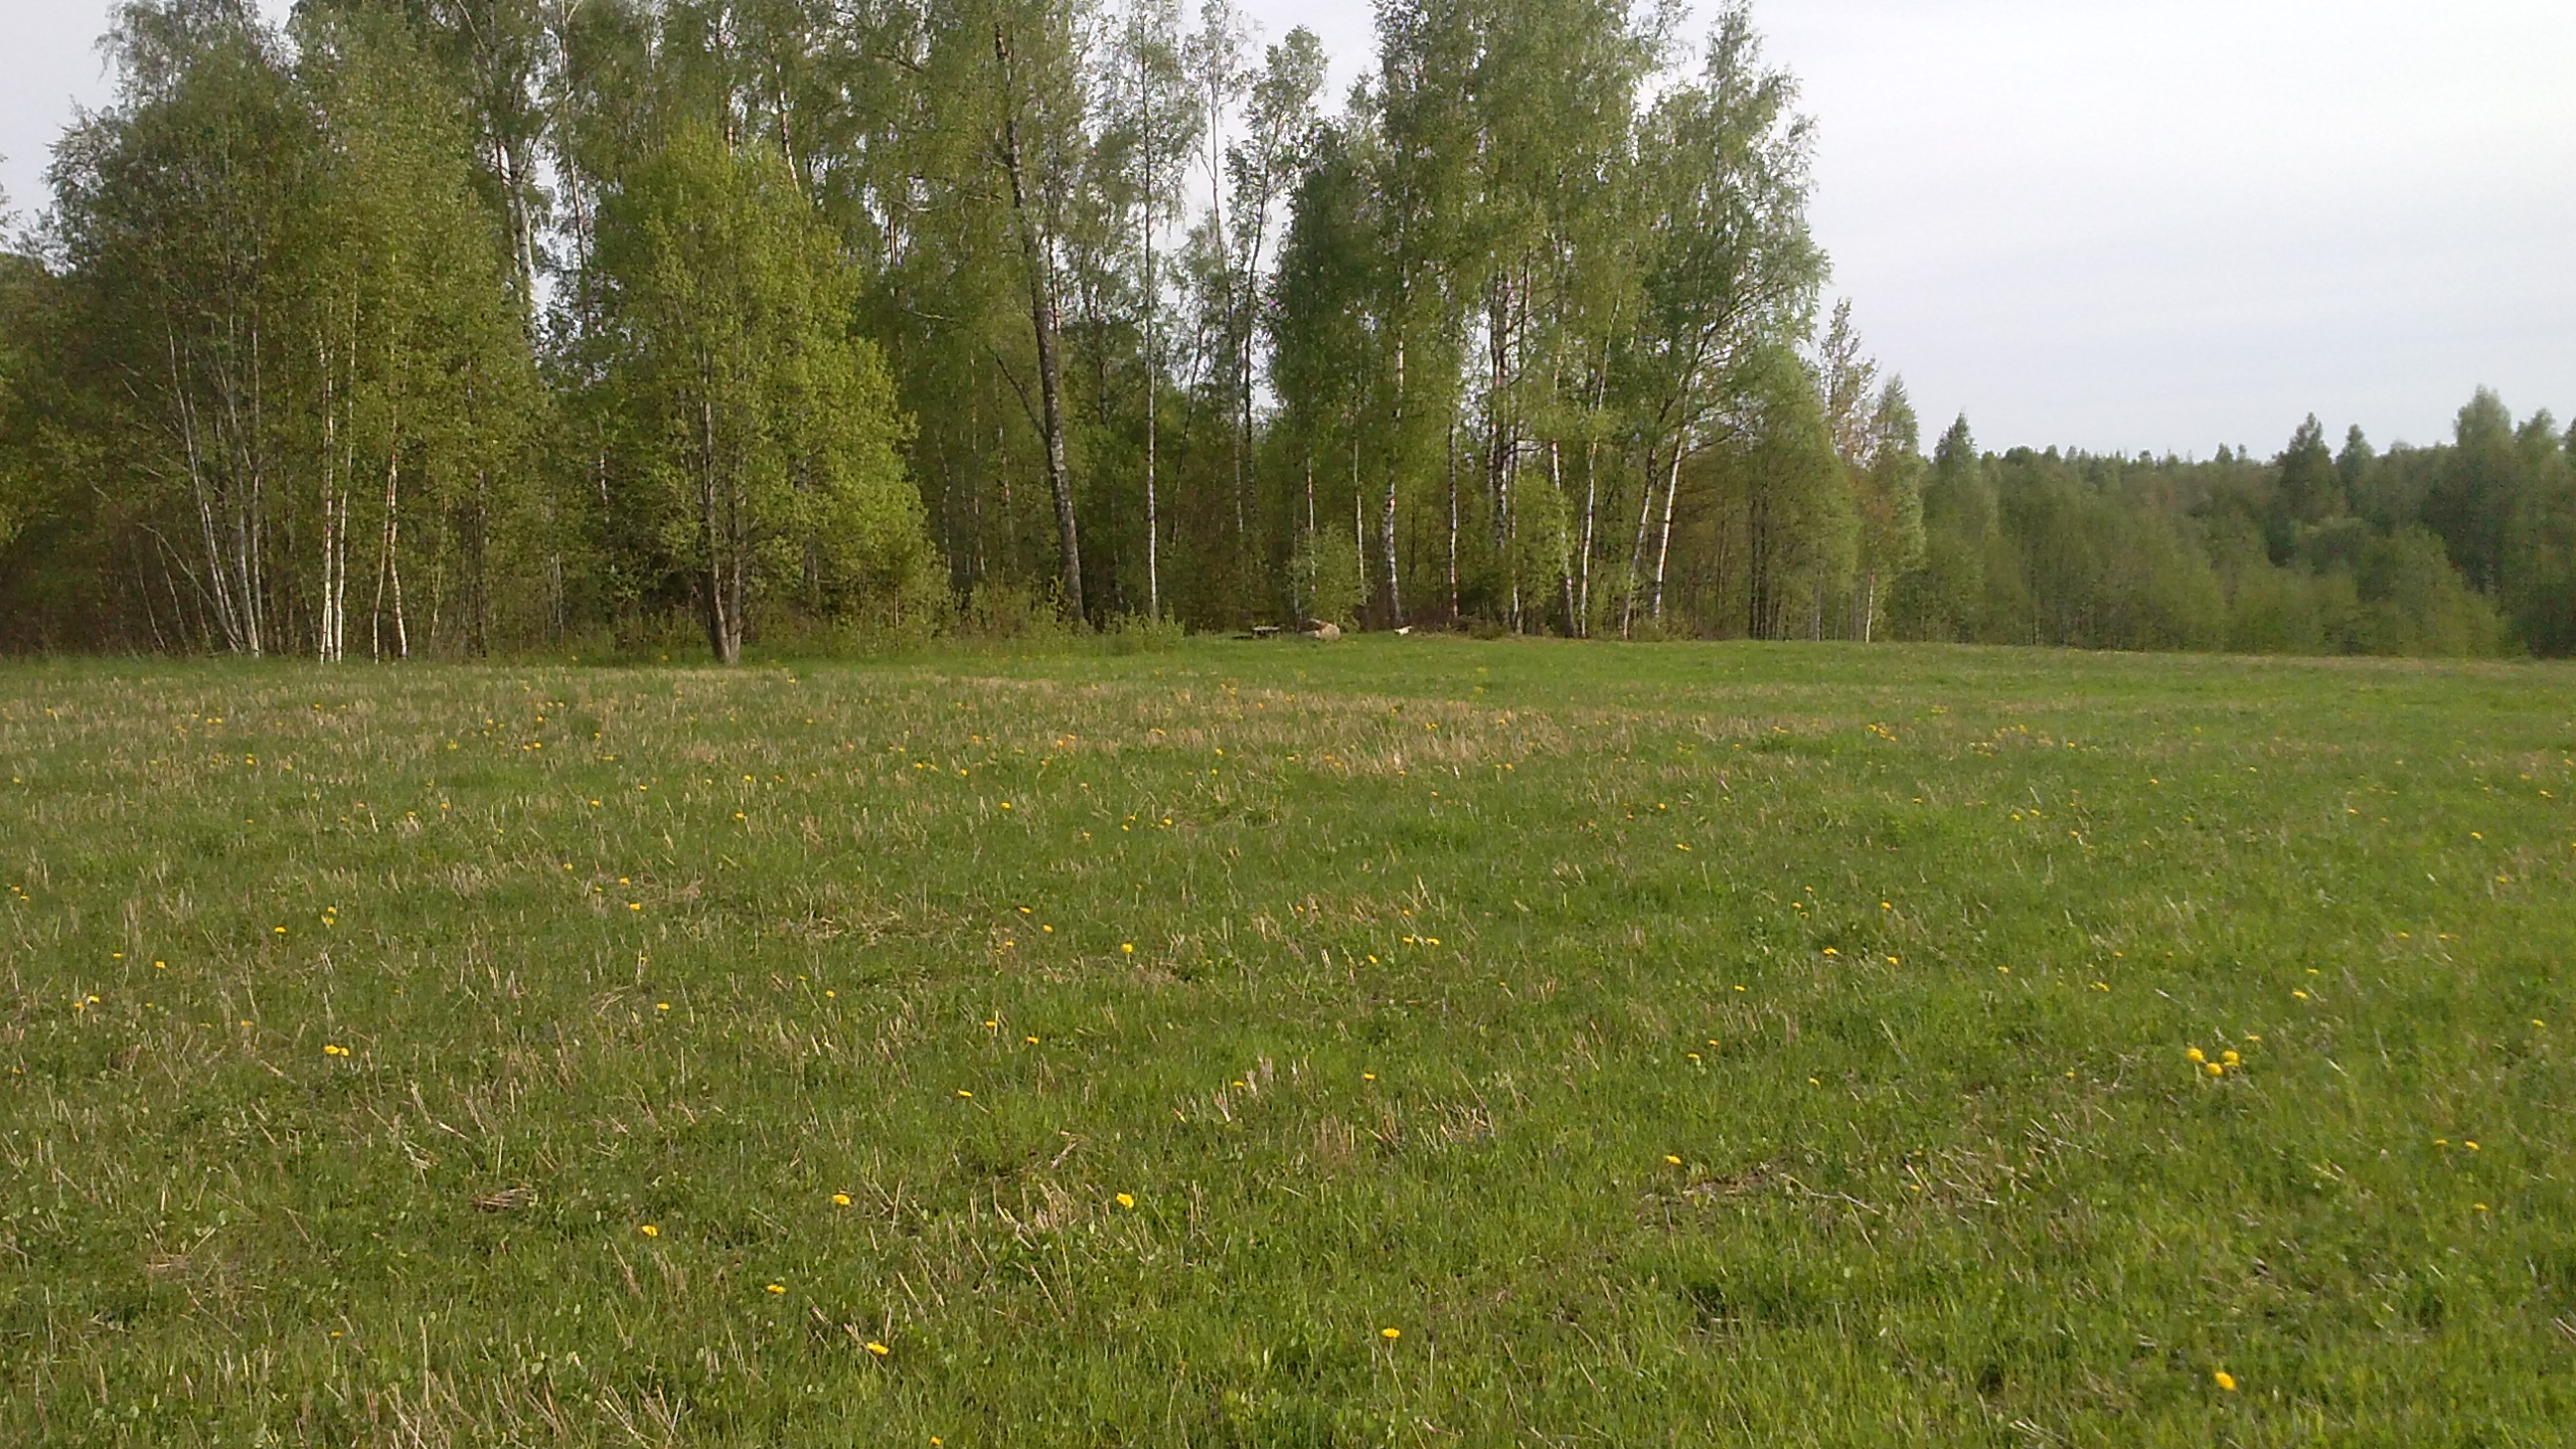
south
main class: Grassland
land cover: Grassland without tree/shrub cover
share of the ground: > 75 %
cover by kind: herbaceous plants 100 %
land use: Agriculture (excluding fallow land and kitchen gardens)
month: May
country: LV
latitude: 56.0103
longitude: 27.5868
